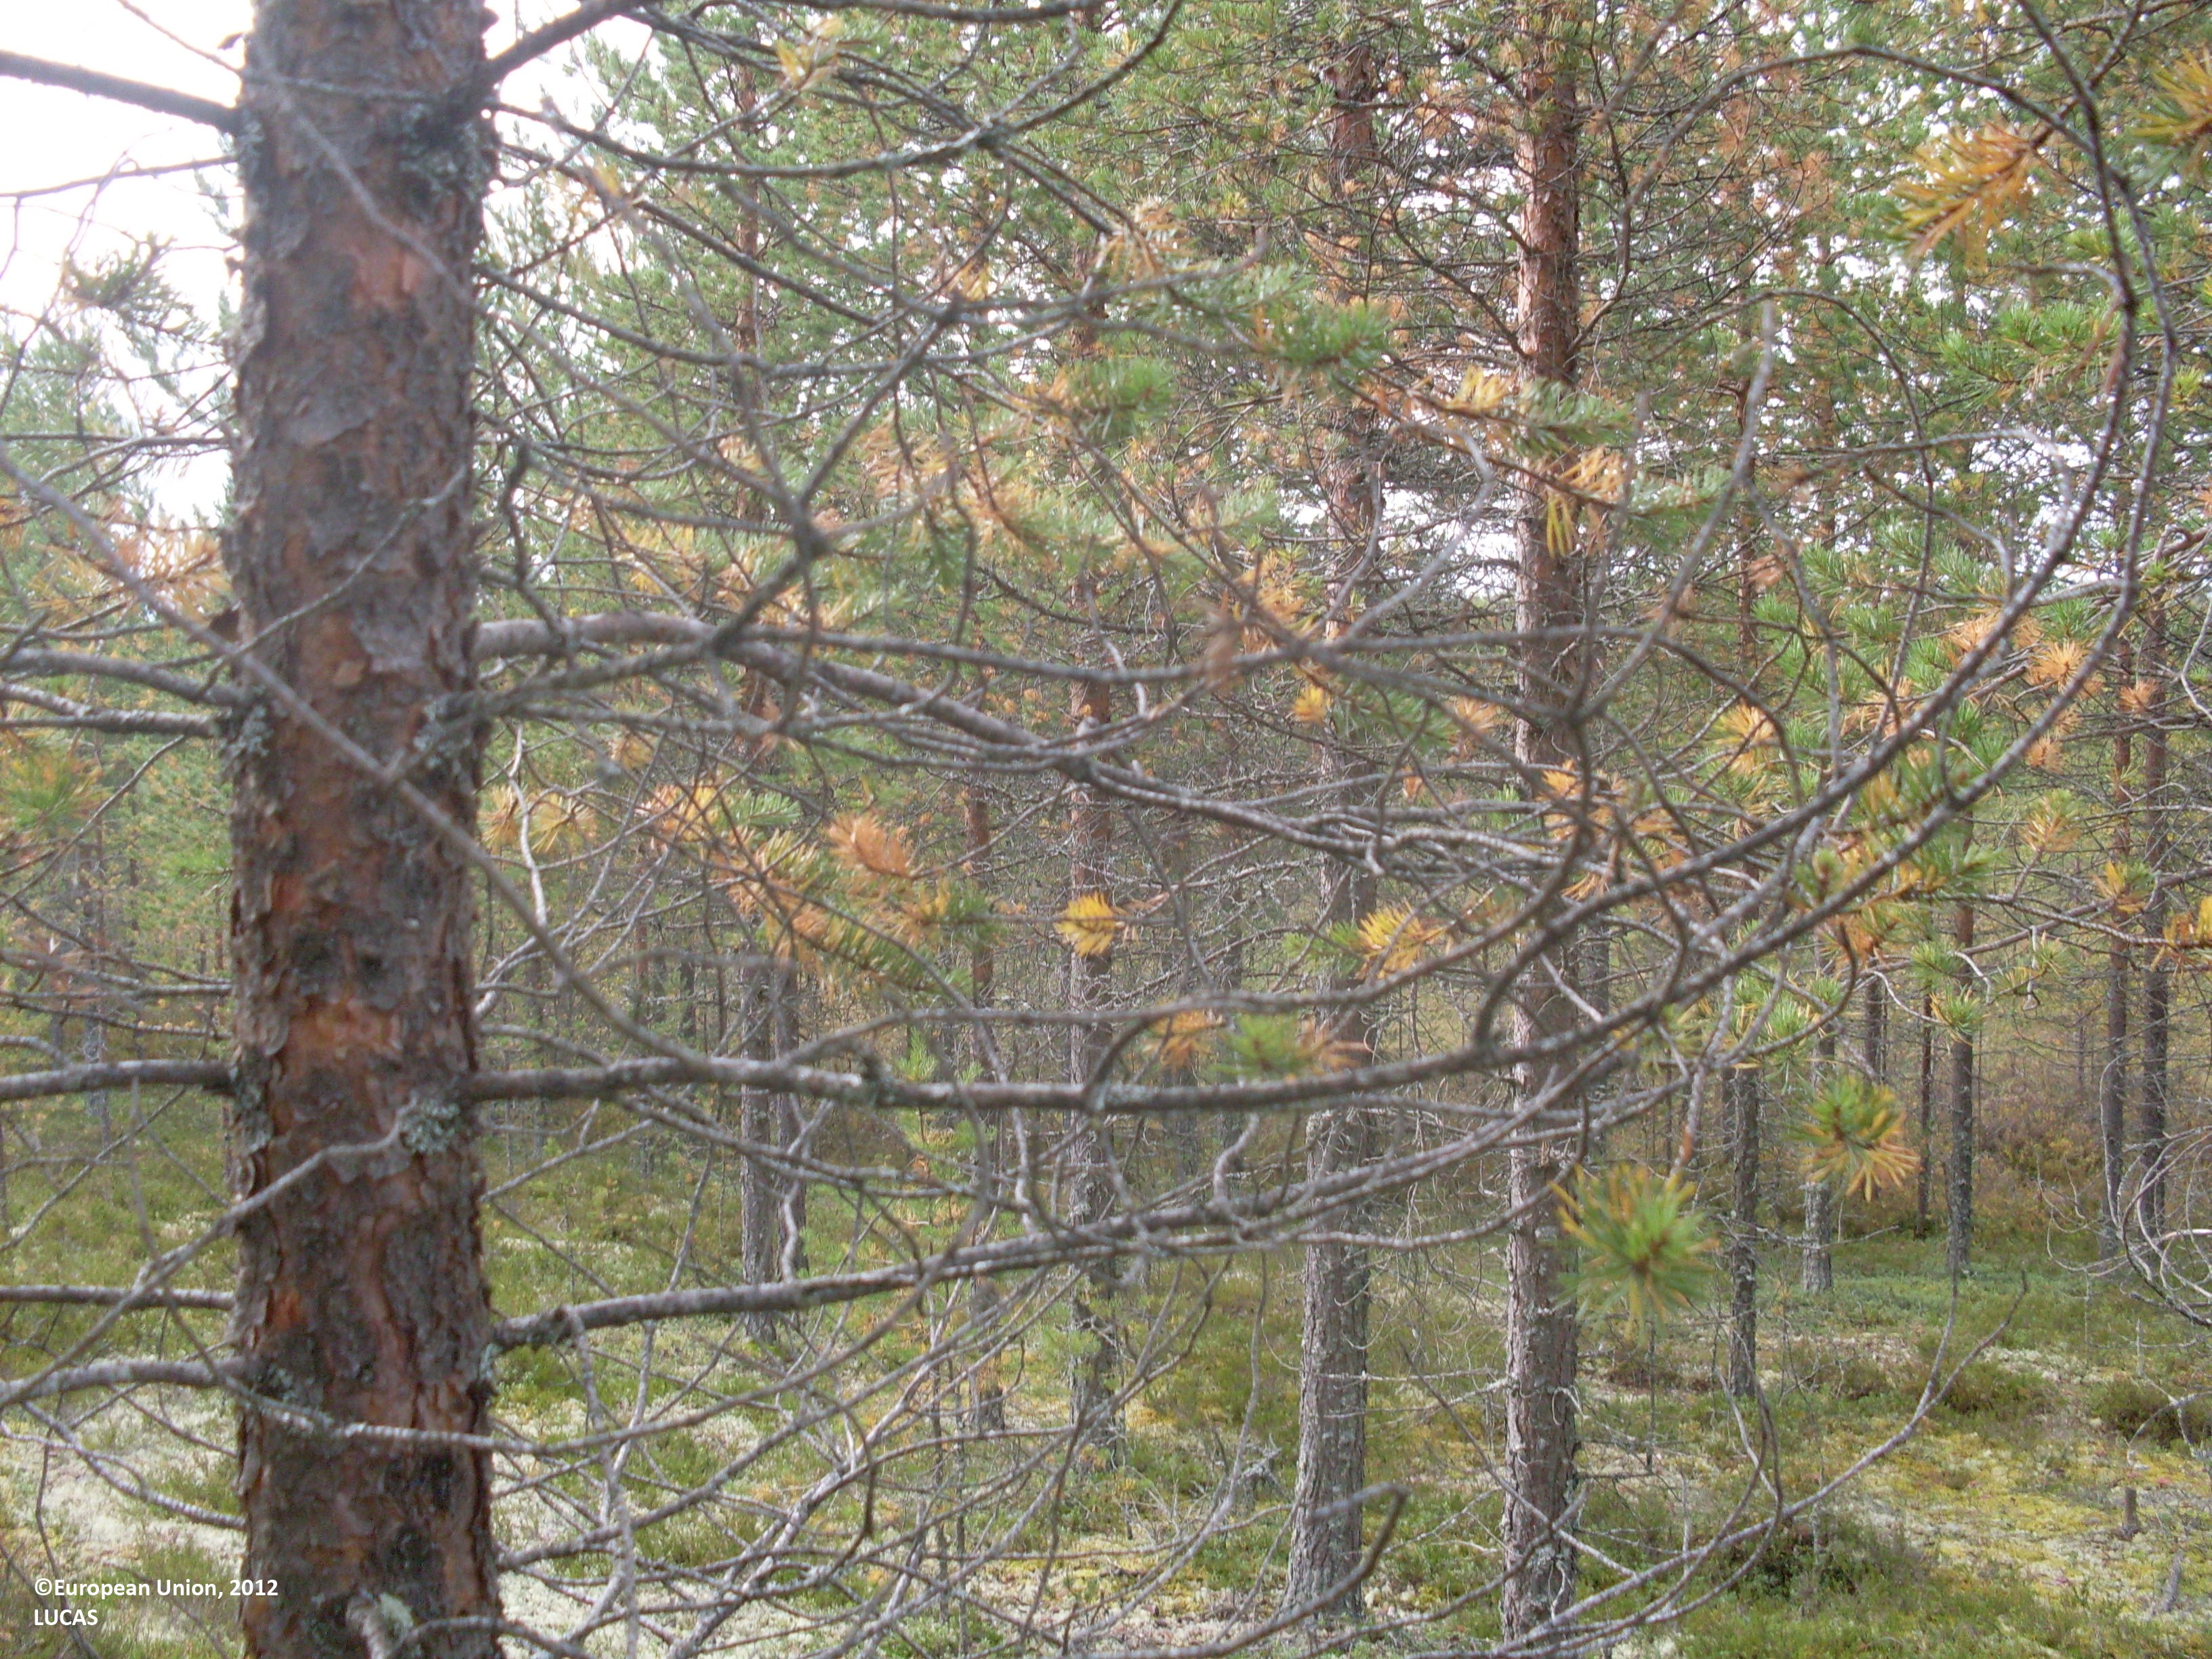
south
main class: Woodland
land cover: Pine dominated coniferous woodland
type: boreal forest
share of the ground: 50 - 75 %
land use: Forestry
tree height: > 5 m
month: September
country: FI
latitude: 64.0789
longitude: 29.5566
